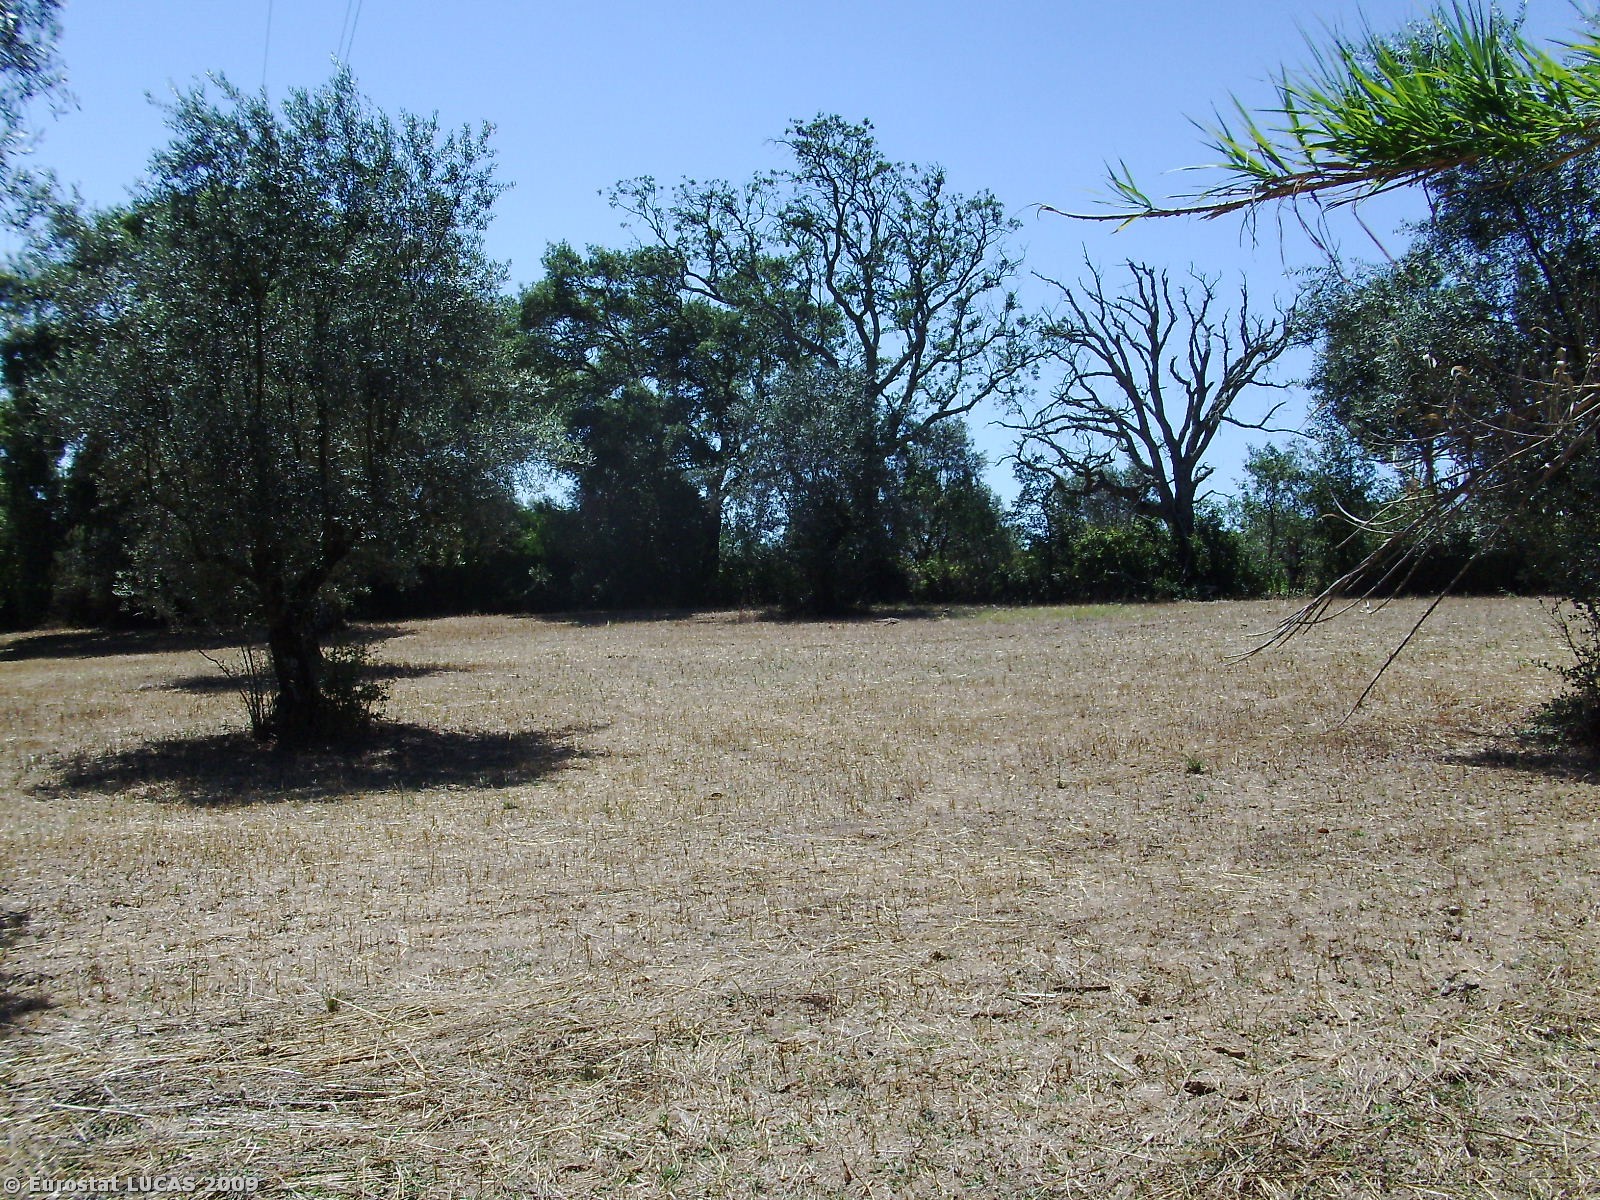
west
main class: Cropland
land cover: Olive groves
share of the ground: 10 - 25 %
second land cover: Spontaneously vegetated surfaces
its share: 50 - 75 %
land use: Agriculture (excluding fallow land and kitchen gardens)
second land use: Fallow land
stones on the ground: 10 - 25 %
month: July
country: PT
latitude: 39.4321
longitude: -8.7956
